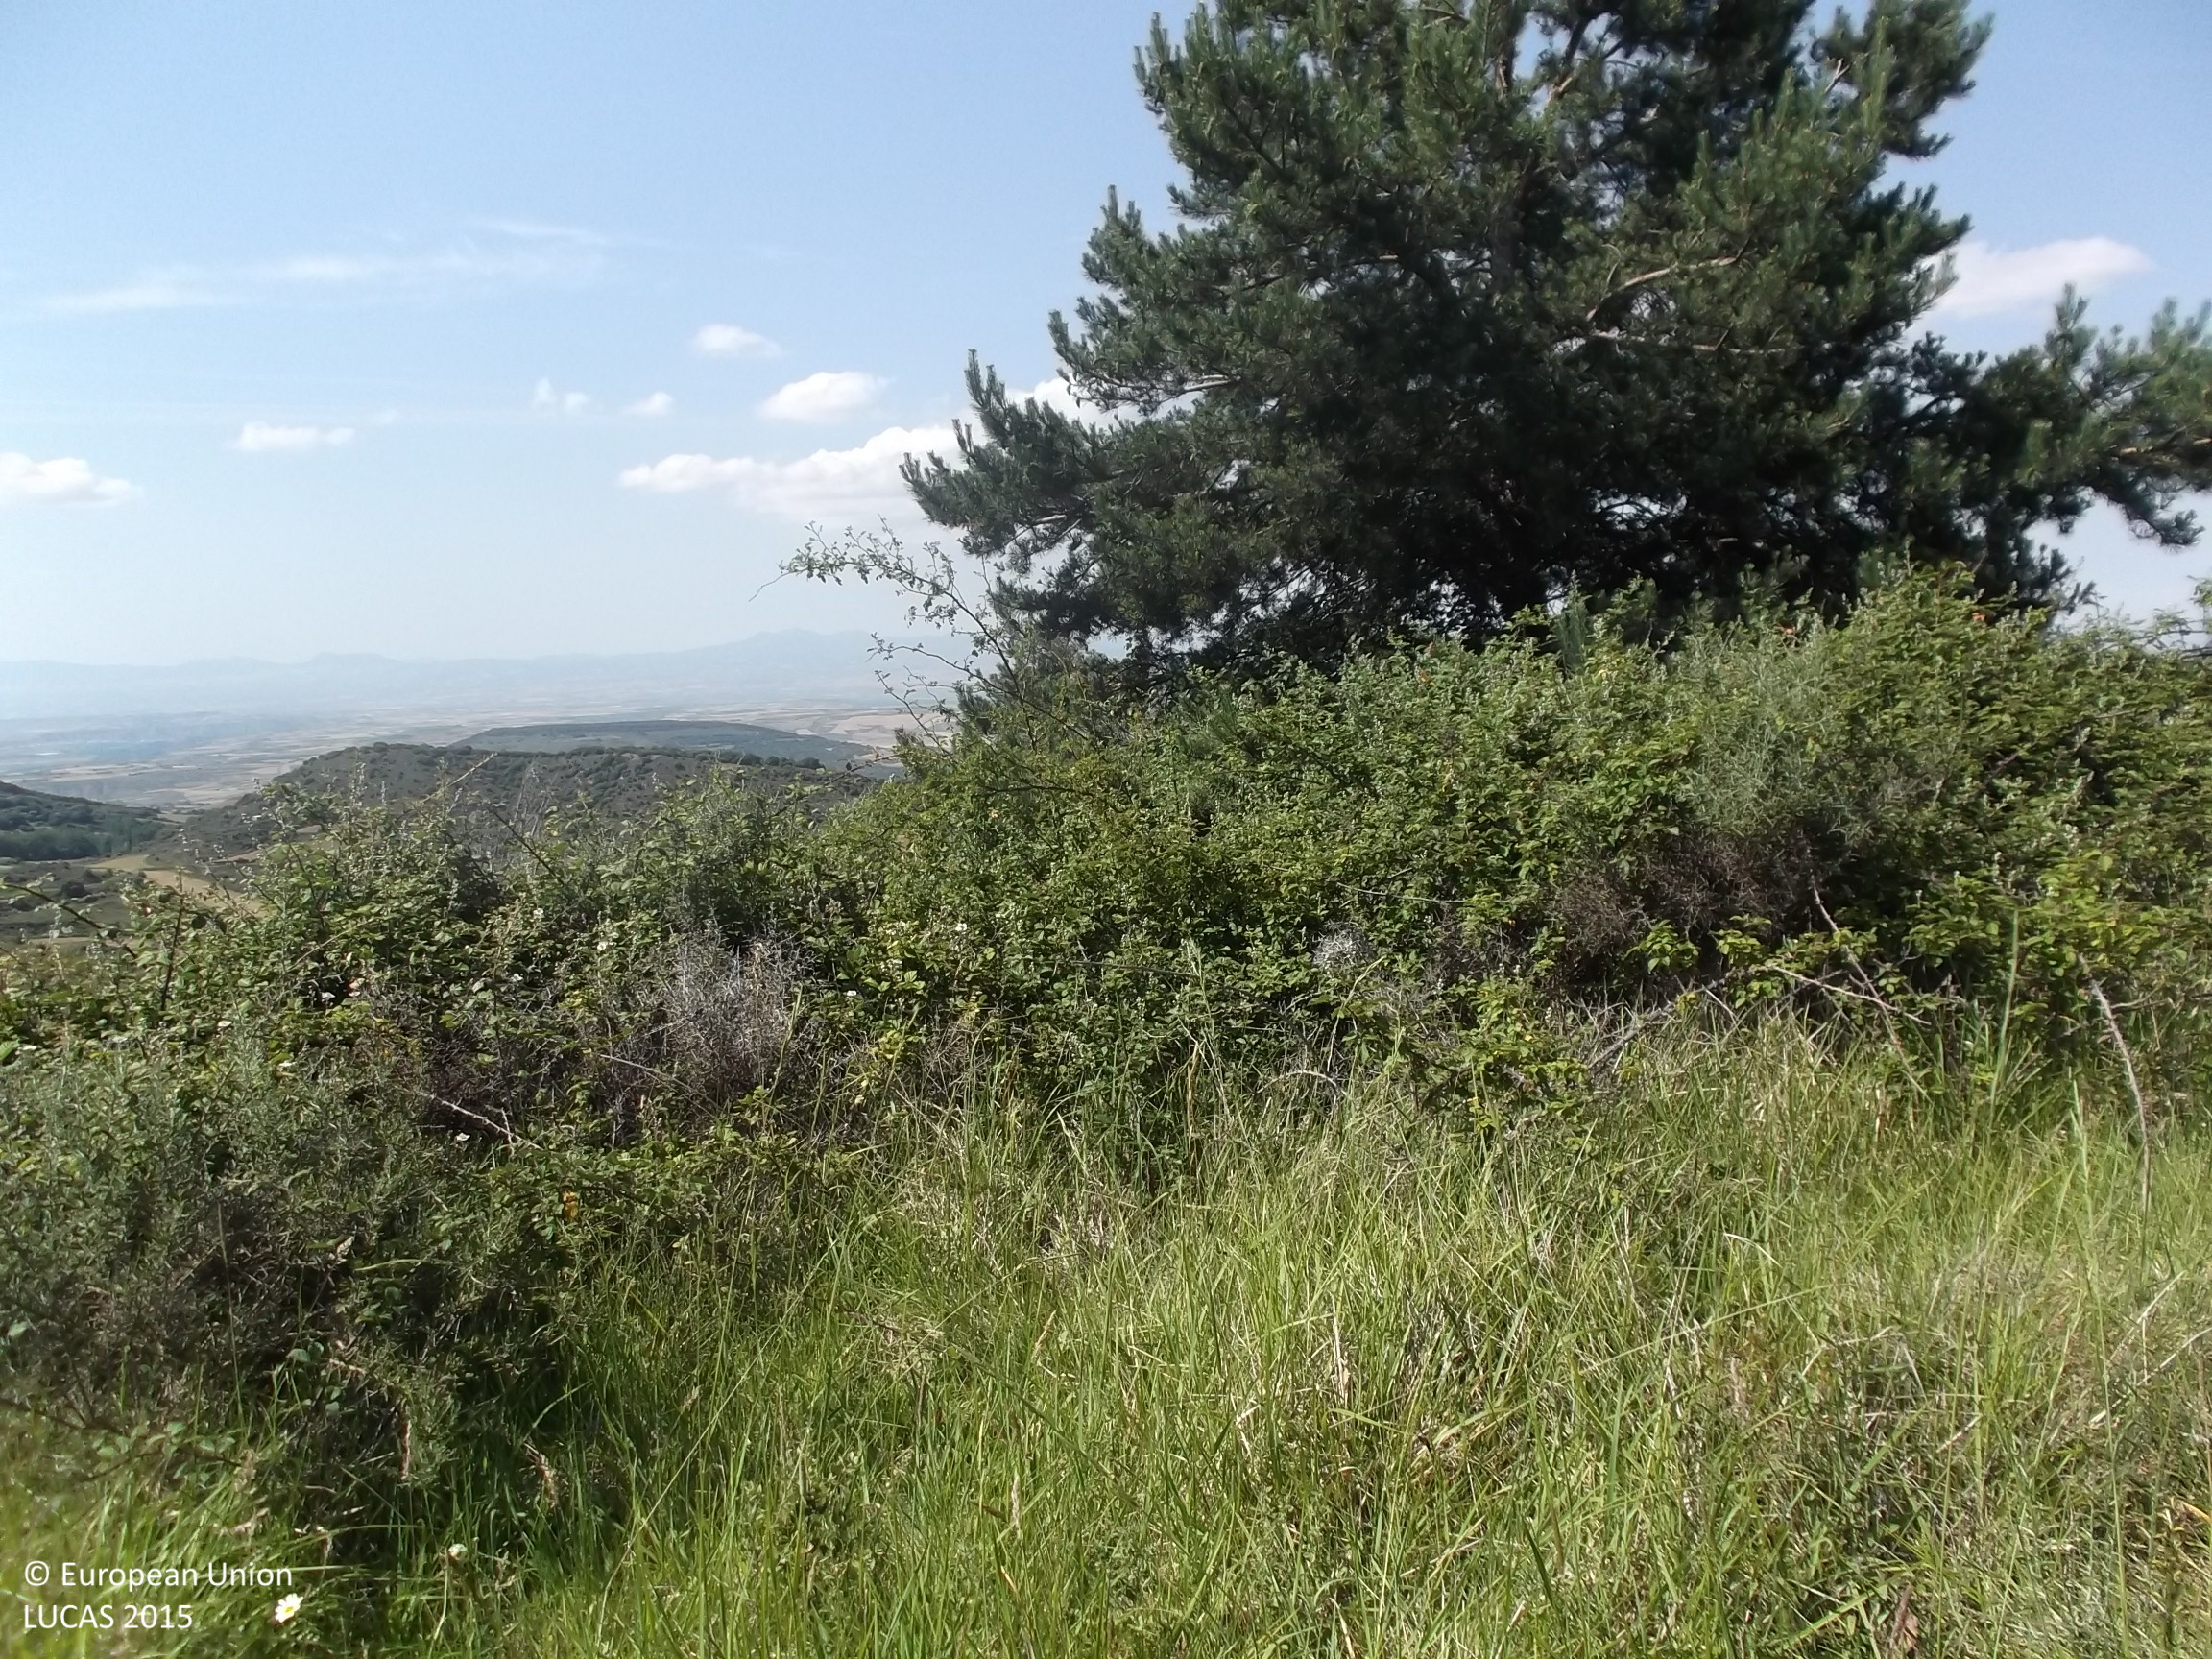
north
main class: Woodland
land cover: Broadleaved woodland
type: broadleaved evergreen forest
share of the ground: 10 - 25 %
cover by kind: shrubs 50 %, herbaceous plants 30 %, broadleaved forest trees 15 %, coniferous forest trees 5 %
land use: Semi-natural and natural areas not in use
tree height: > 5 m
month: June
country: ES
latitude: 42.2931
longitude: -2.2298
